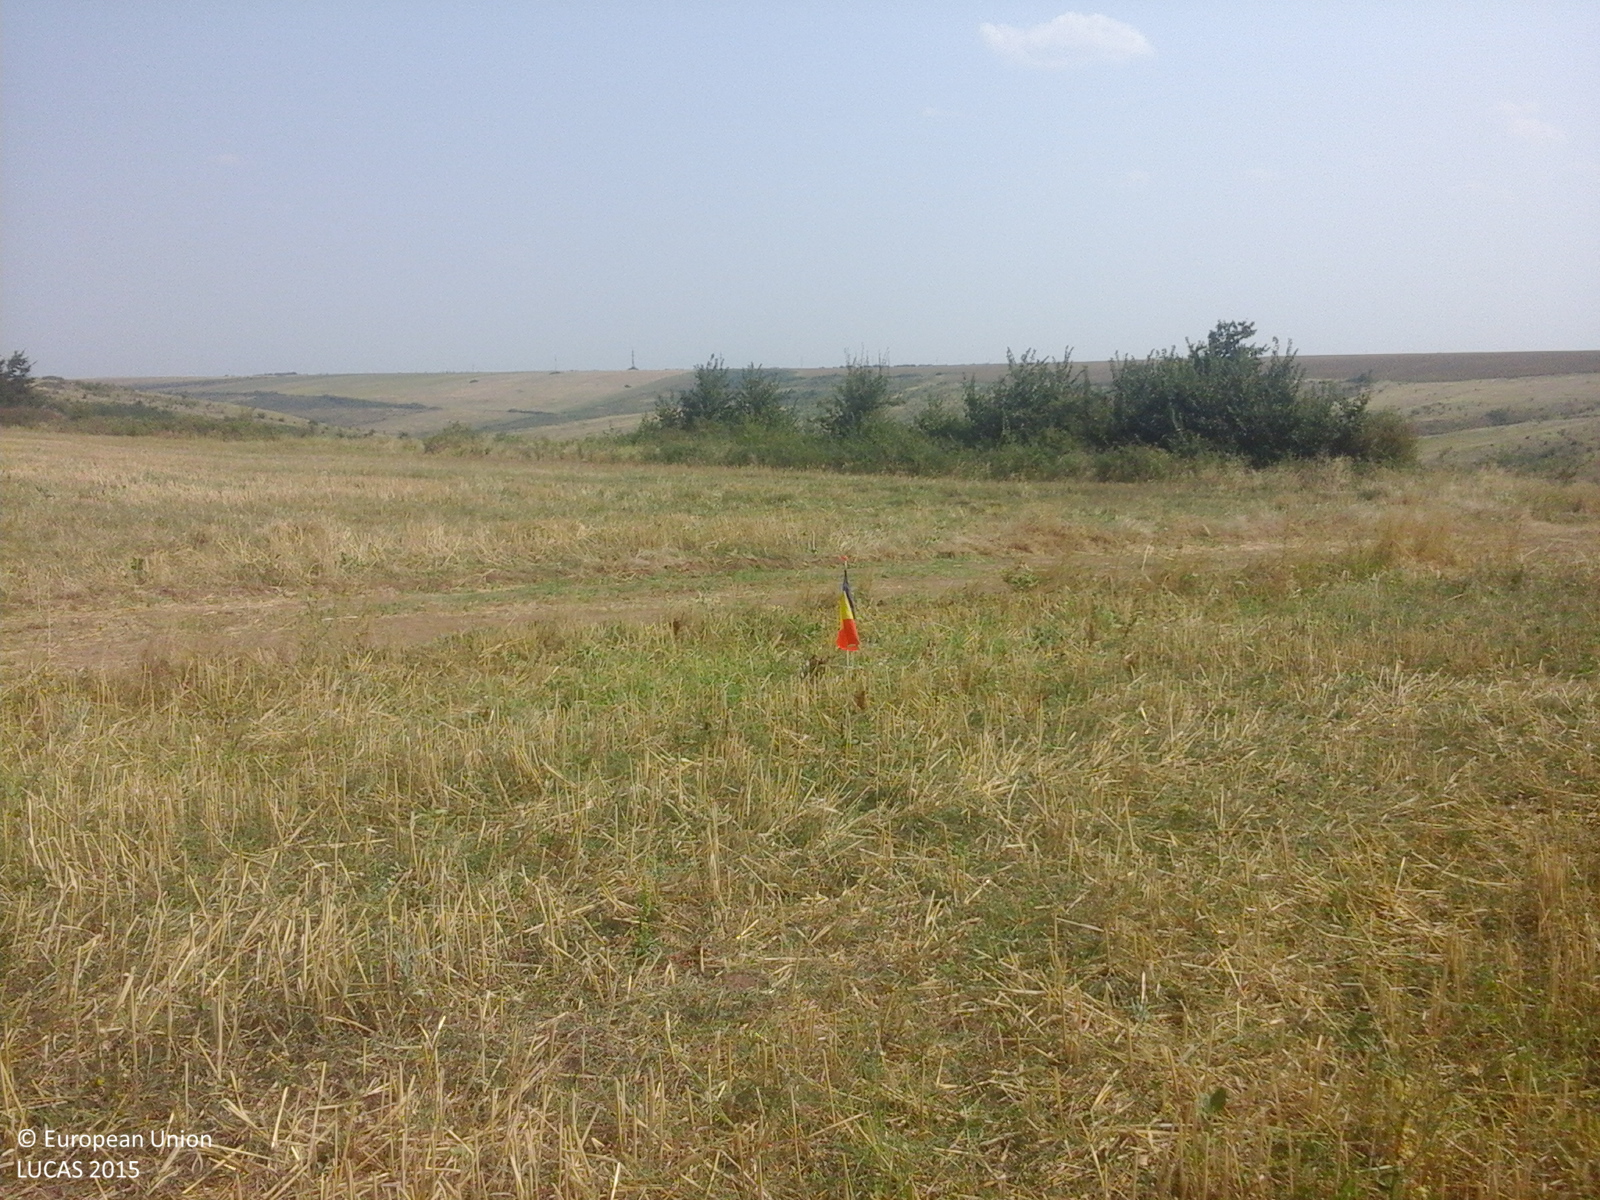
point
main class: Cropland
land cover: Durum wheat
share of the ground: 25 - 50 %
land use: Agriculture (excluding fallow land and kitchen gardens)
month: August
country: RO
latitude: 44.2389
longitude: 23.7154
